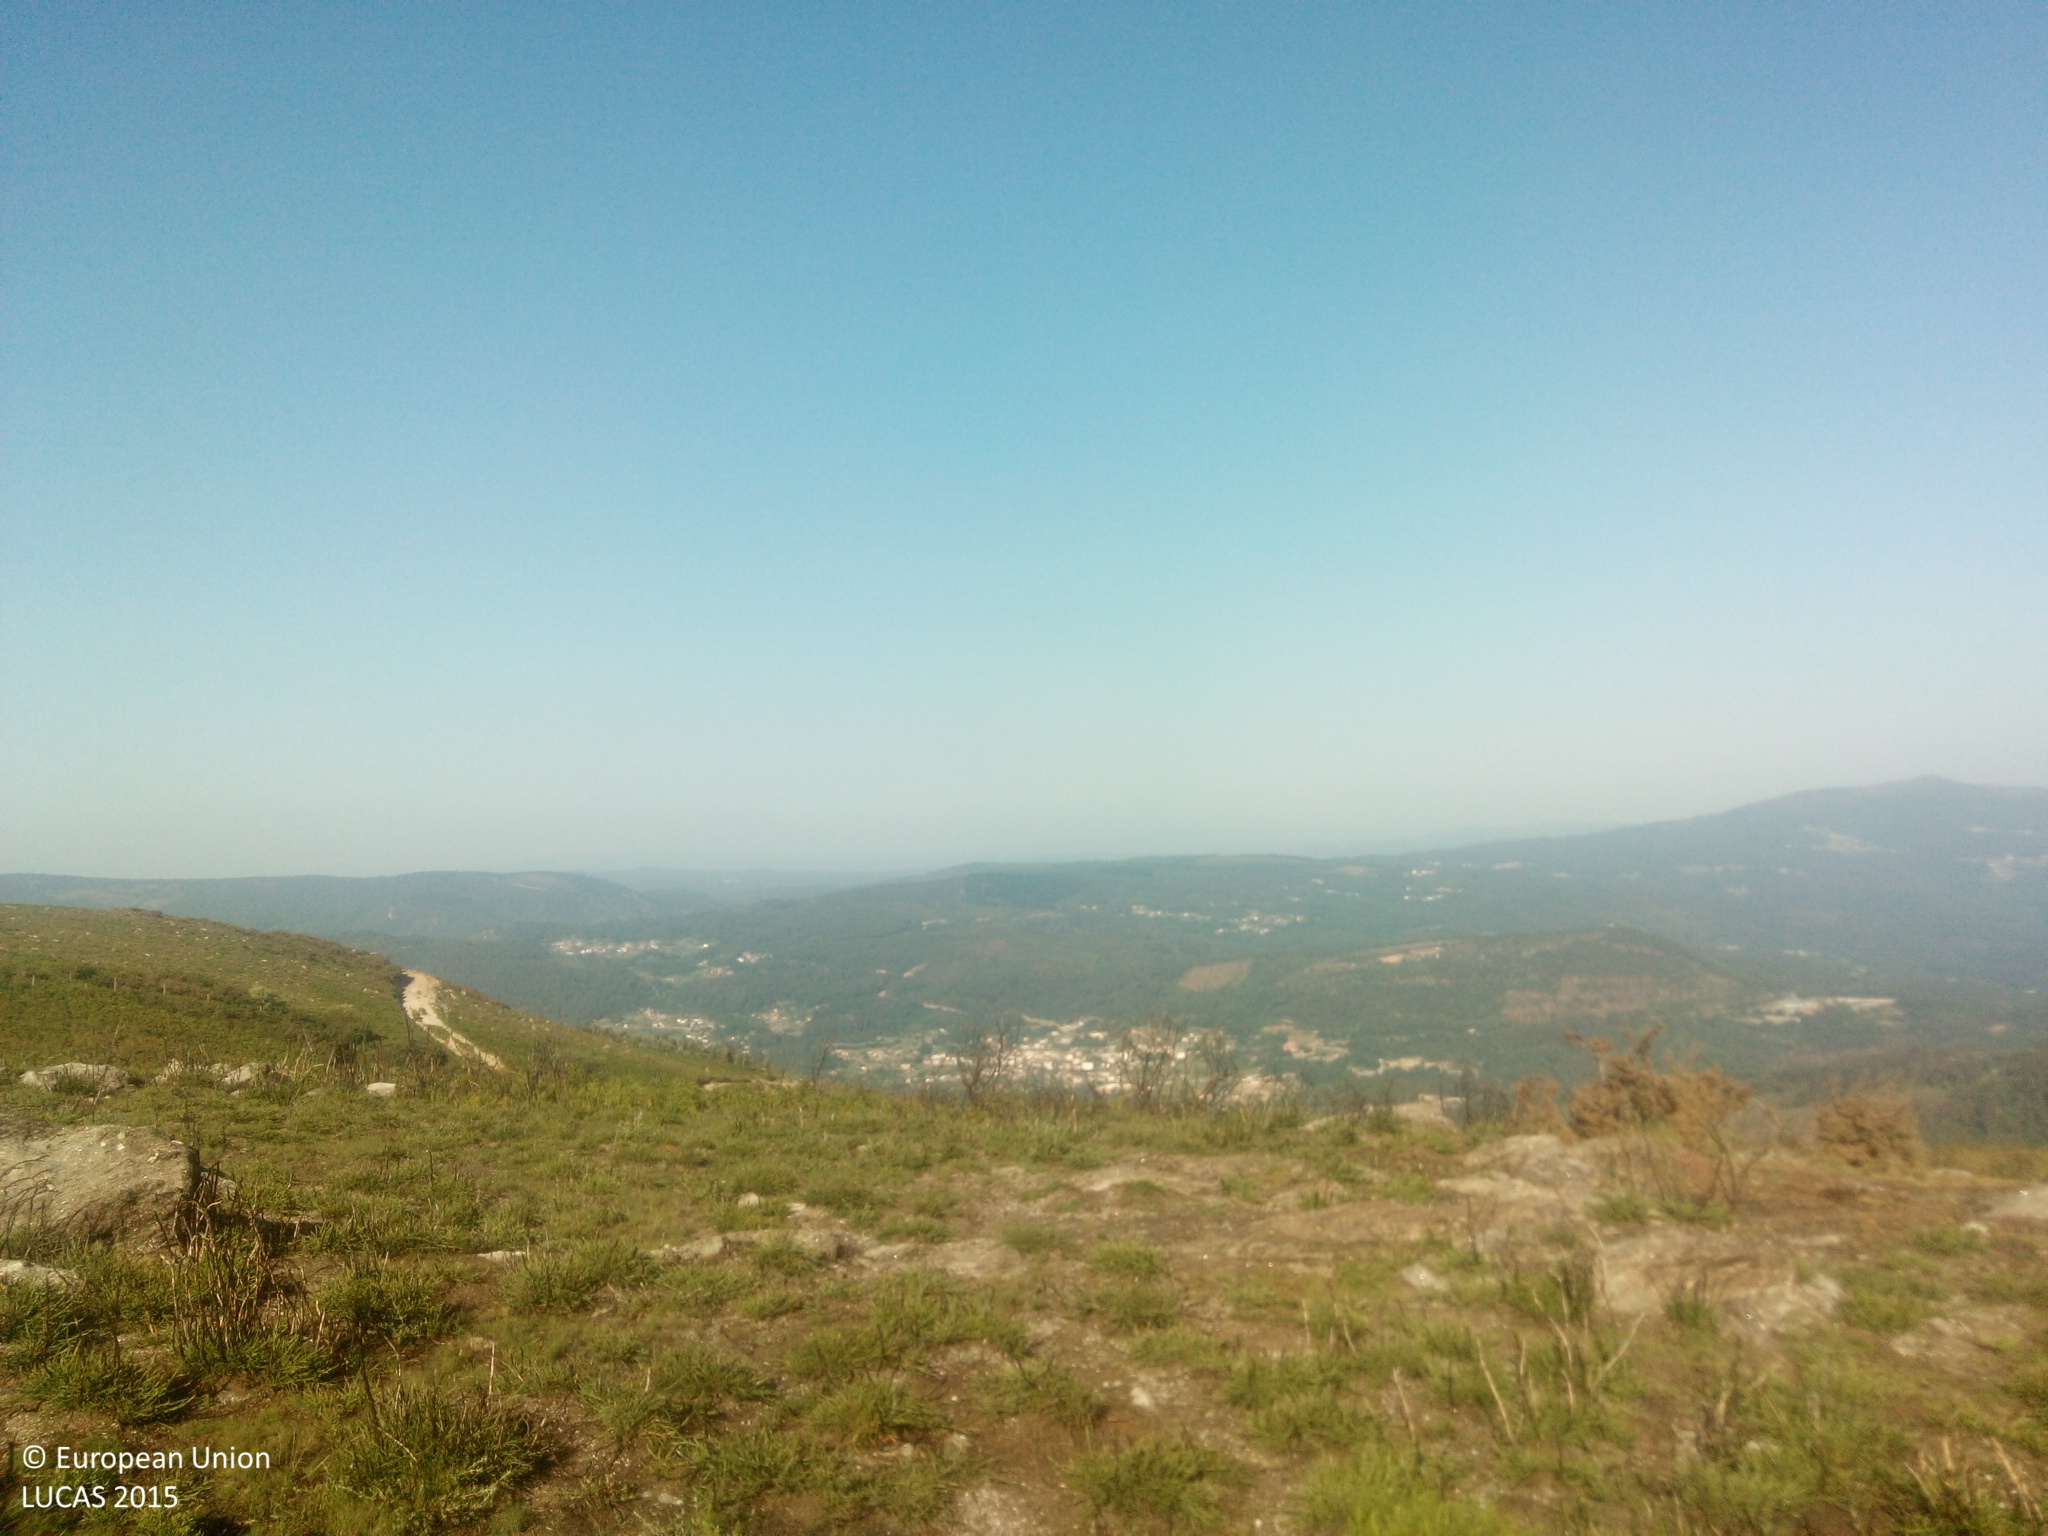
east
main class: Shrubland
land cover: Shrubland without tree cover
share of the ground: > 75 %
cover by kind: shrubs 100 %
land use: Semi-natural and natural areas not in use
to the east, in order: Shrubland without tree cover; Rock outcrops; Shrubland without tree cover; Tracks; Shrubland without tree cover; Tracks; Shrubland without tree cover; Shrubland with sparse tree cover
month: June
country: ES
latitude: 42.2043
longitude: -8.2165
